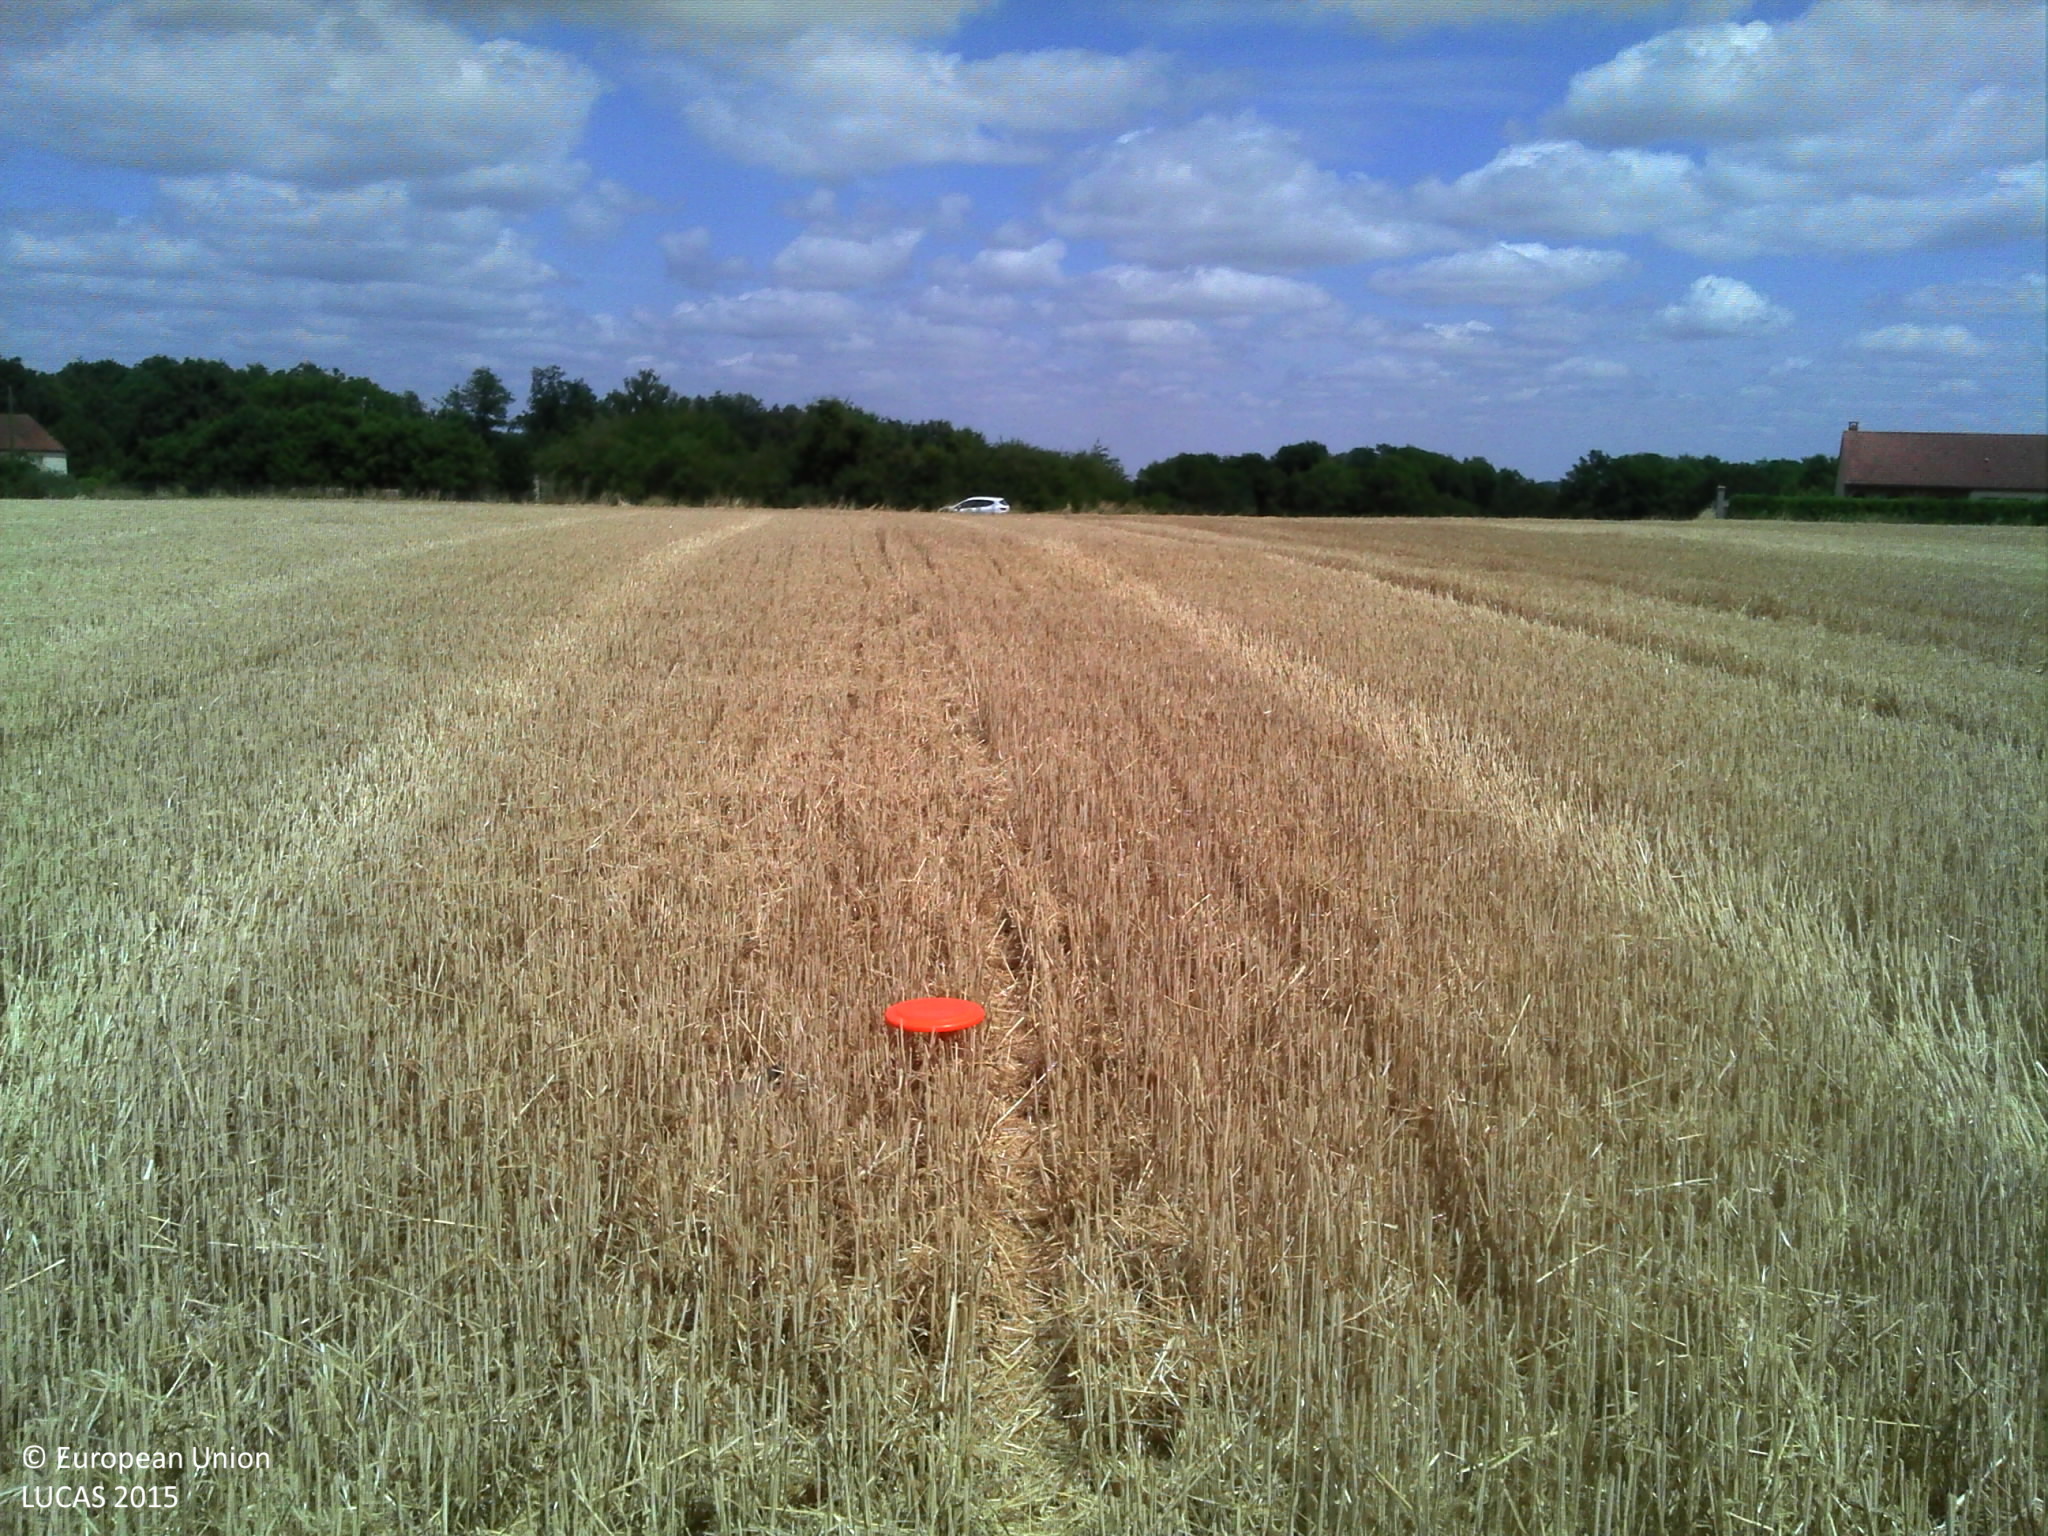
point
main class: Cropland
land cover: Common wheat
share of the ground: > 75 %
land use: Agriculture (excluding fallow land and kitchen gardens)
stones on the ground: 10 - 25 %
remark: Harvested field
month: July
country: FR
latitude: 47.7218
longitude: 3.4498
